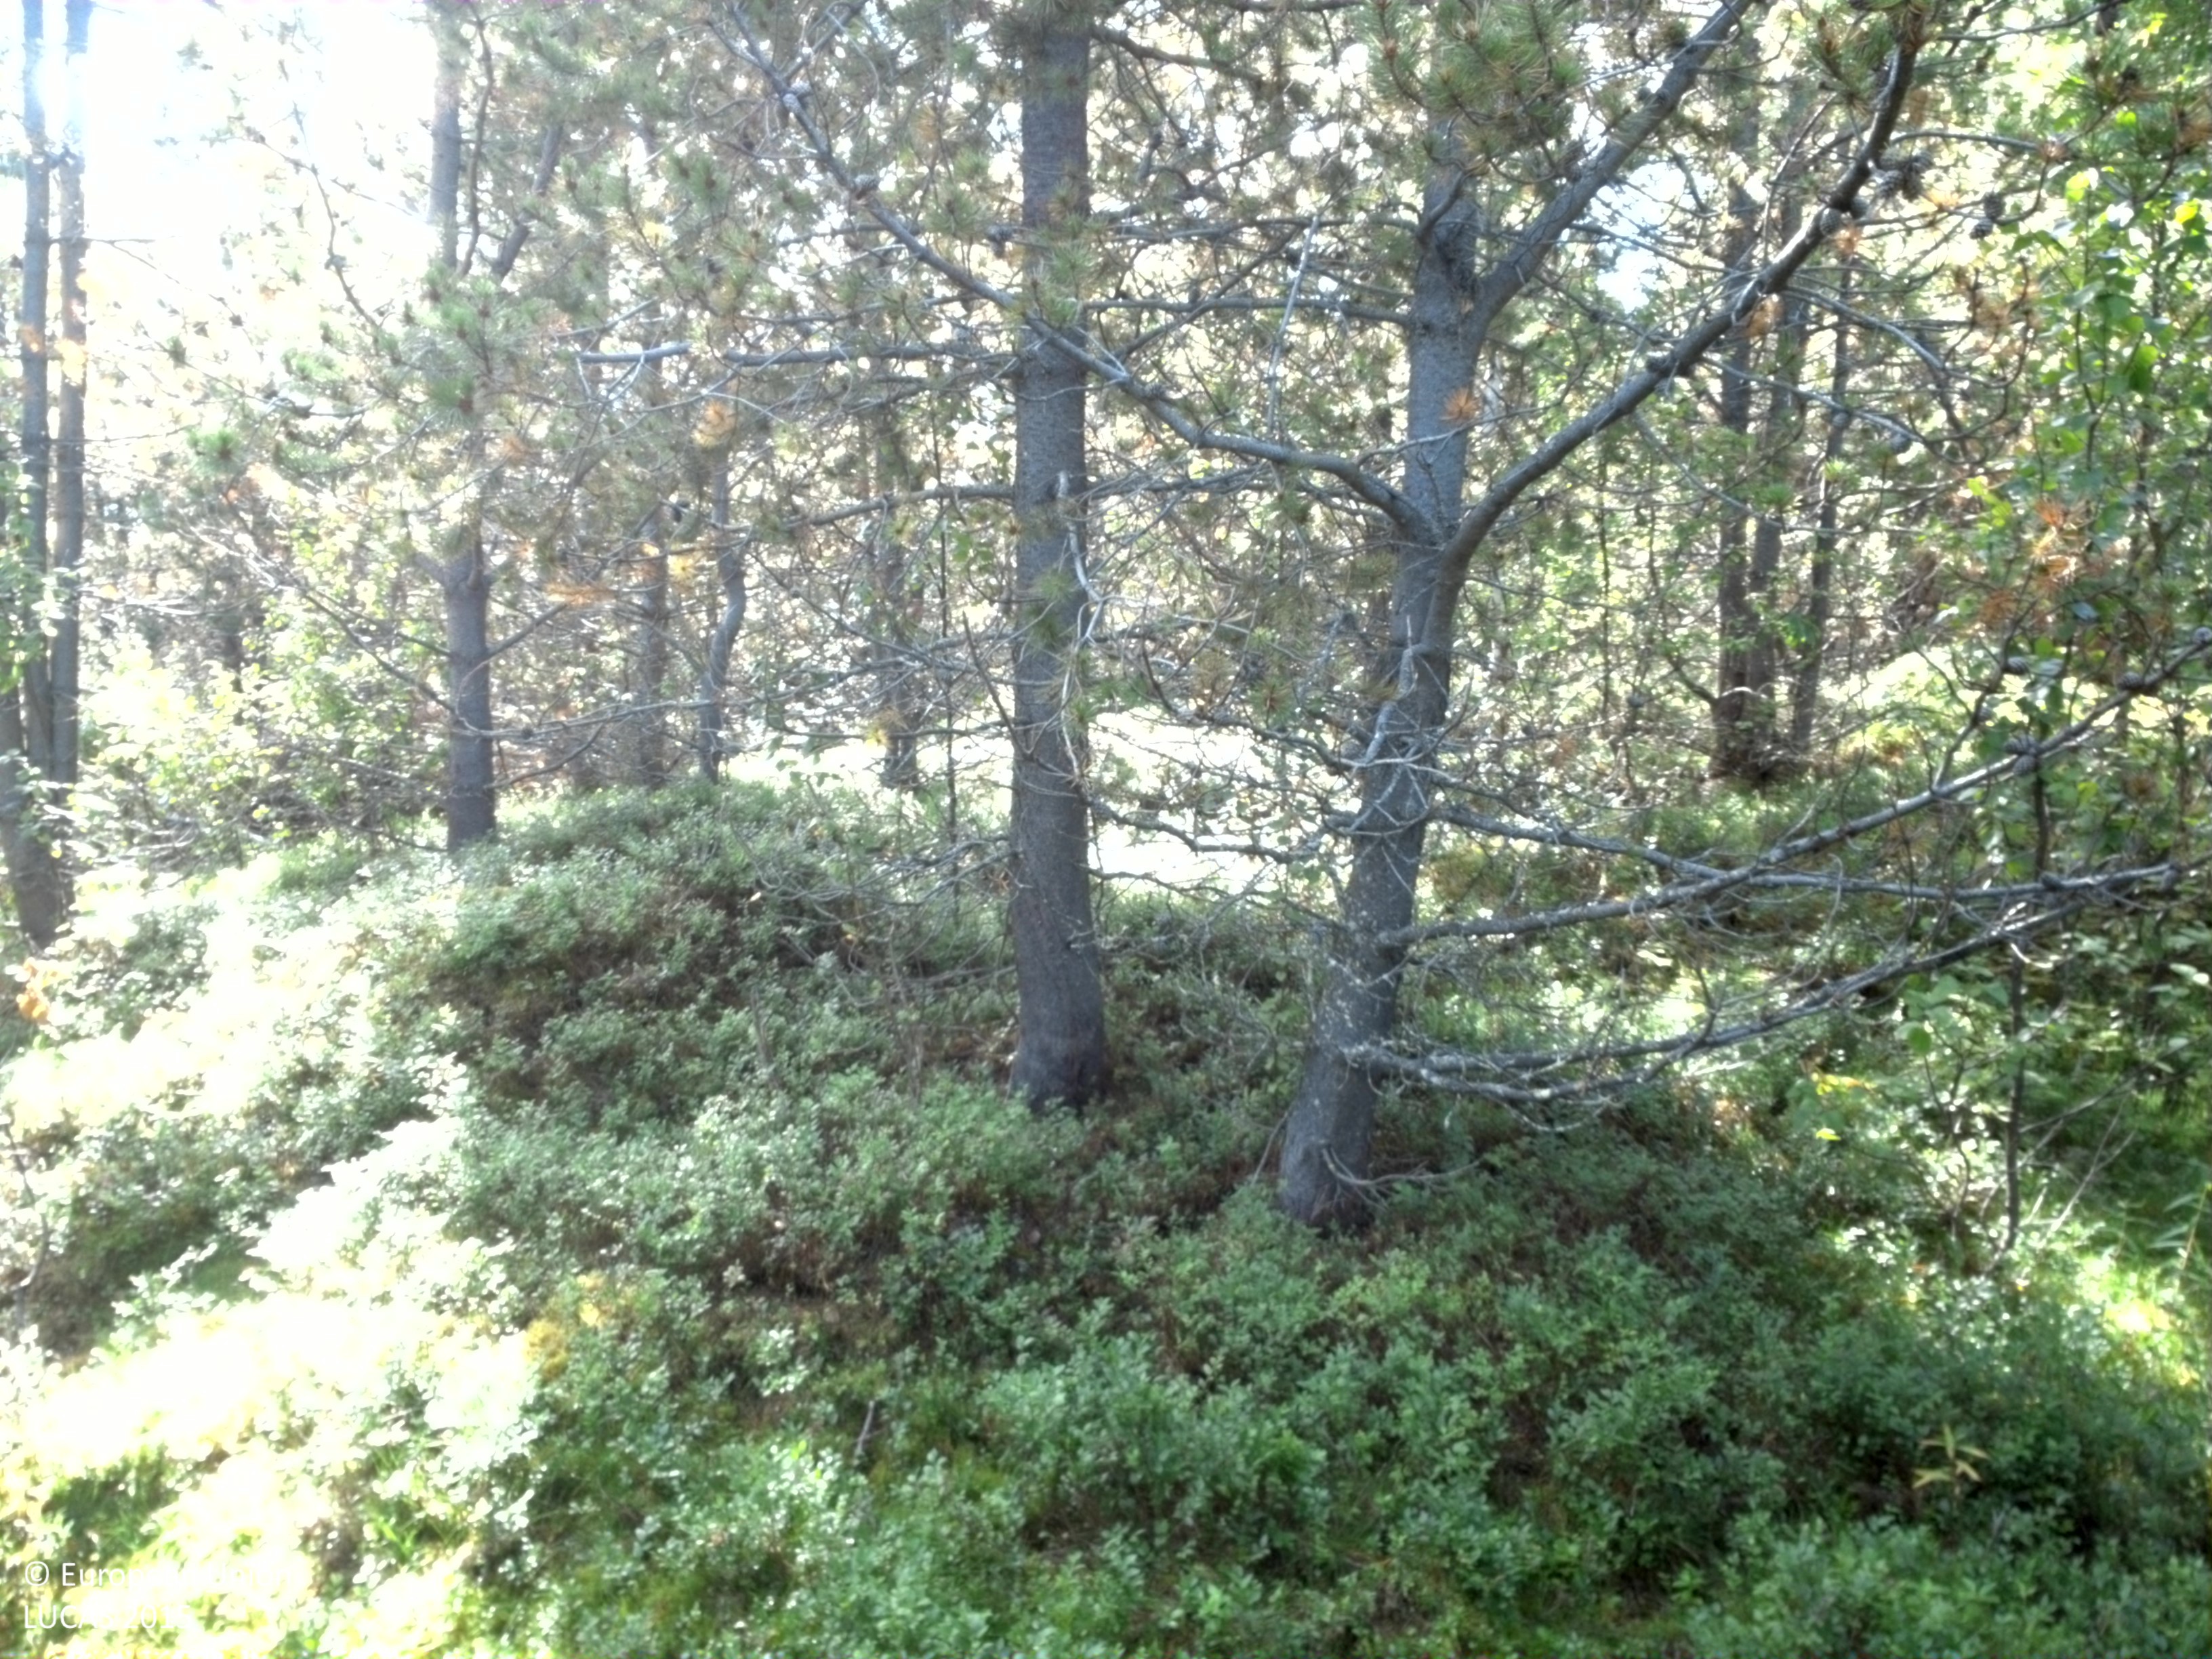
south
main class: Woodland
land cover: Pine dominated mixed woodland
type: exotic forest
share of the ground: 50 - 75 %
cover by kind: coniferous forest trees 35 %, shrubs 25 %, herbaceous plants 20 %, broadleaved forest trees 15 %, lichens and mosses 5 %
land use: Forestry
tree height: > 5 m
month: September
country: SE
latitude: 65.0614
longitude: 16.5322
